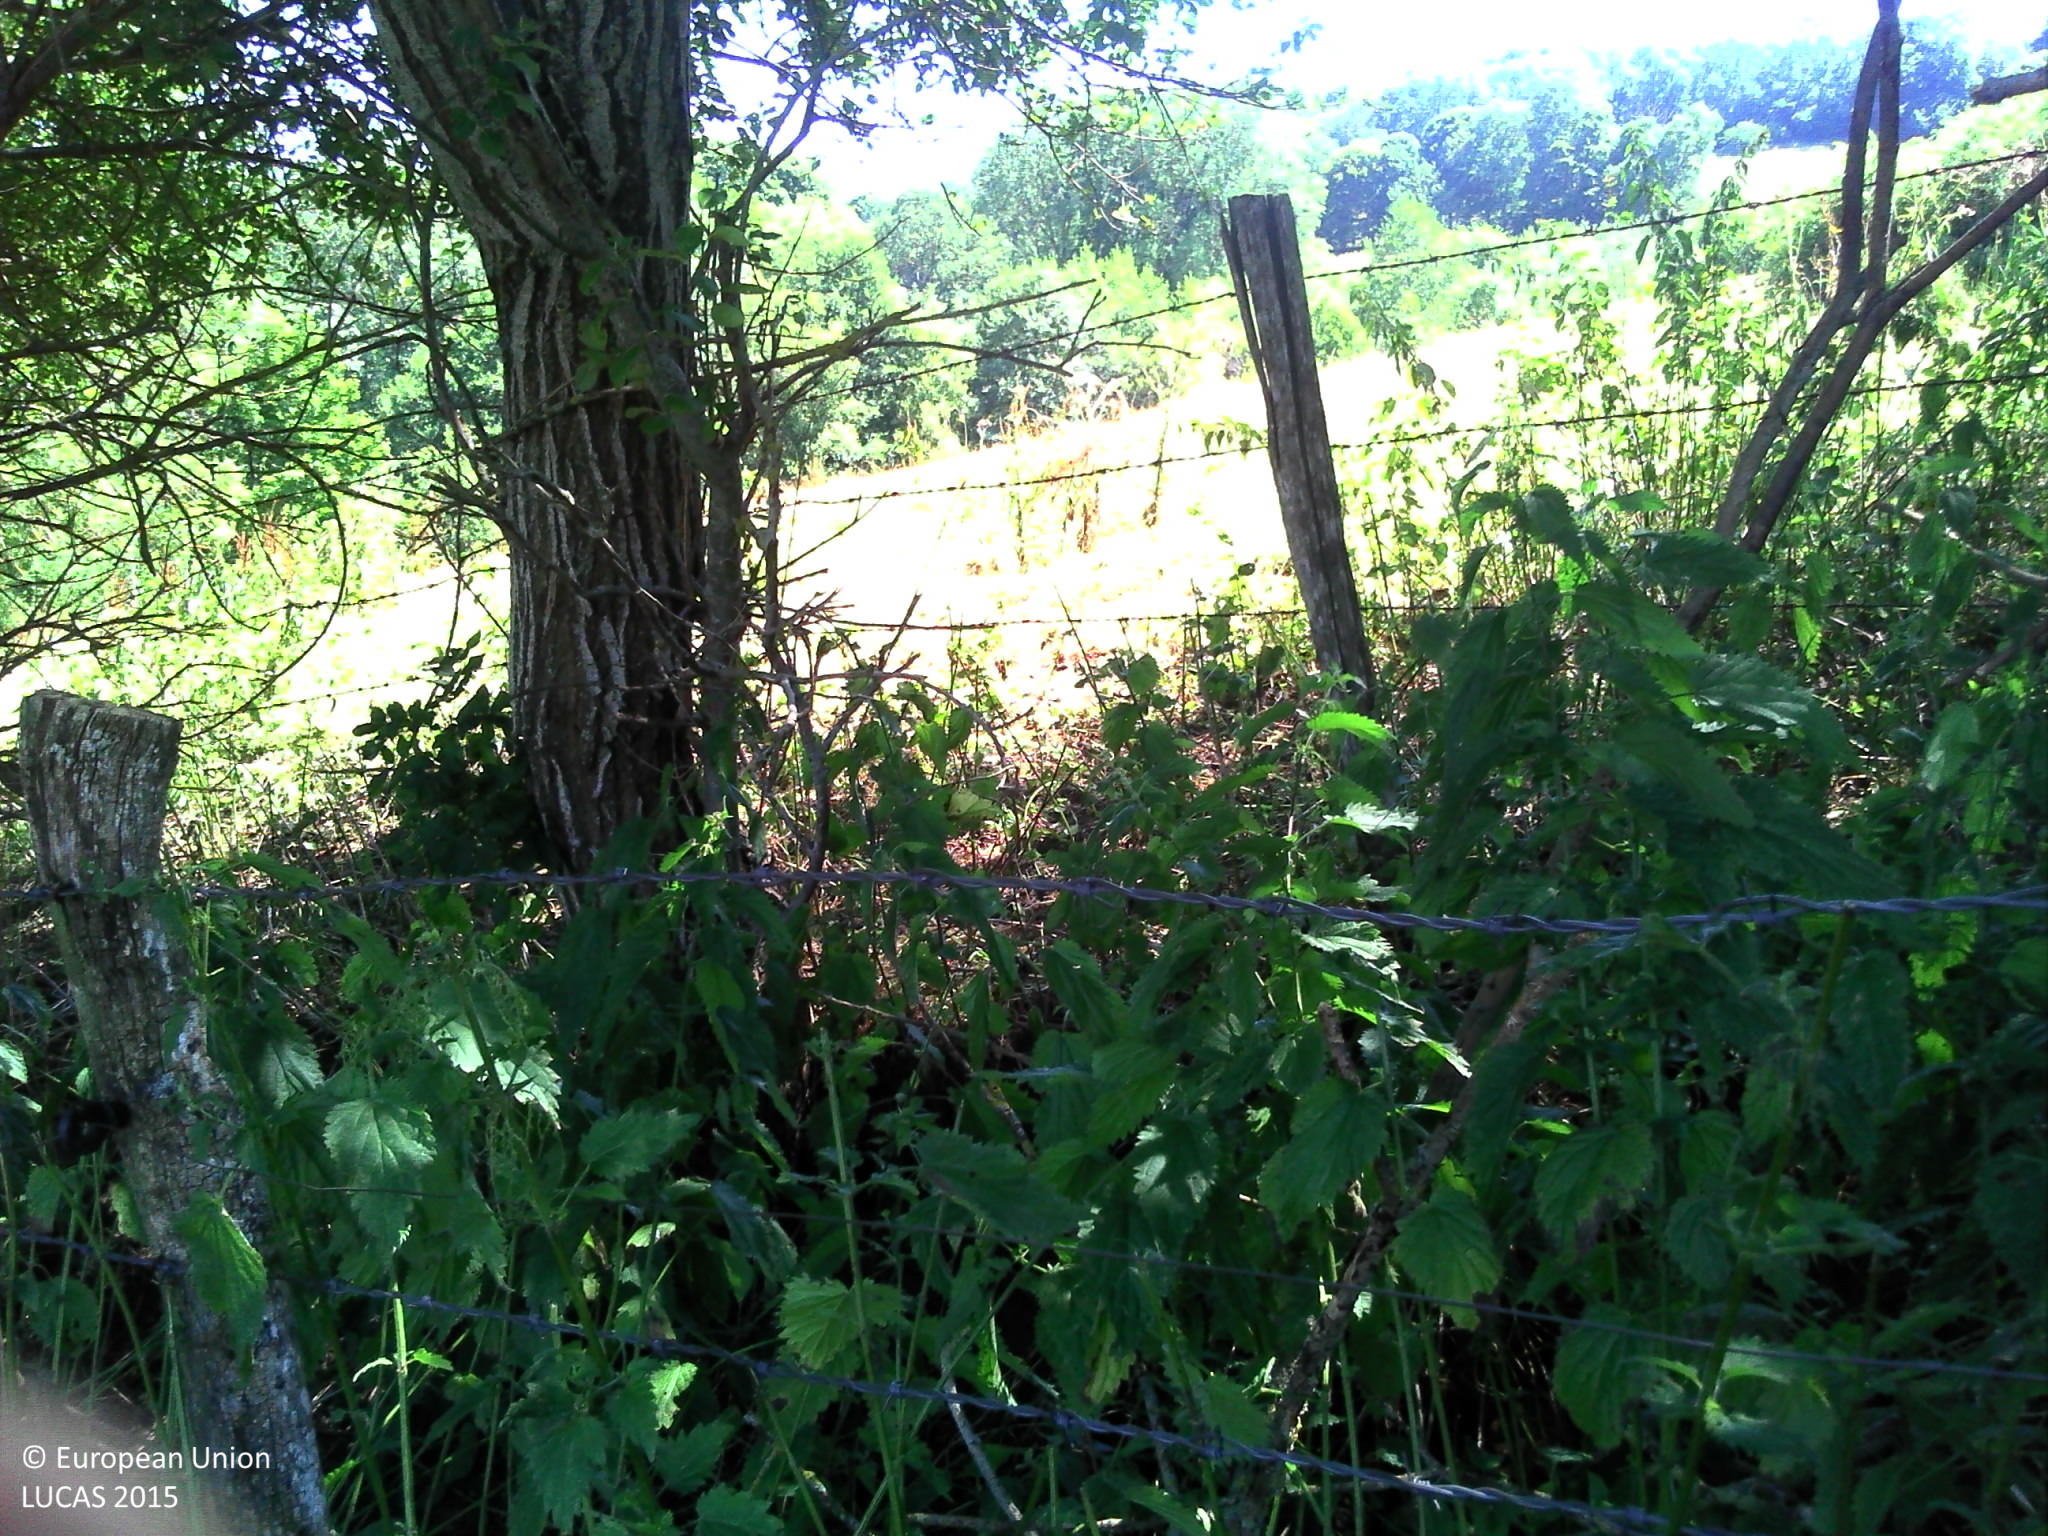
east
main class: Woodland
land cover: Broadleaved woodland
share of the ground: > 75 %
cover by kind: herbaceous plants 80 %, broadleaved forest trees 20 %
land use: Agriculture (excluding fallow land and kitchen gardens)
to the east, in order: Broadleaved woodland; Fences; Ditches and canals; Fences; Grassland without tree/shrub cover; Broadleaved woodland; Grassland without tree/shrub cover; Broadleaved woodland; Grassland without tree/shrub cover; Broadleaved woodland
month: August
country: FR
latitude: 45.6794
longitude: 2.8739
